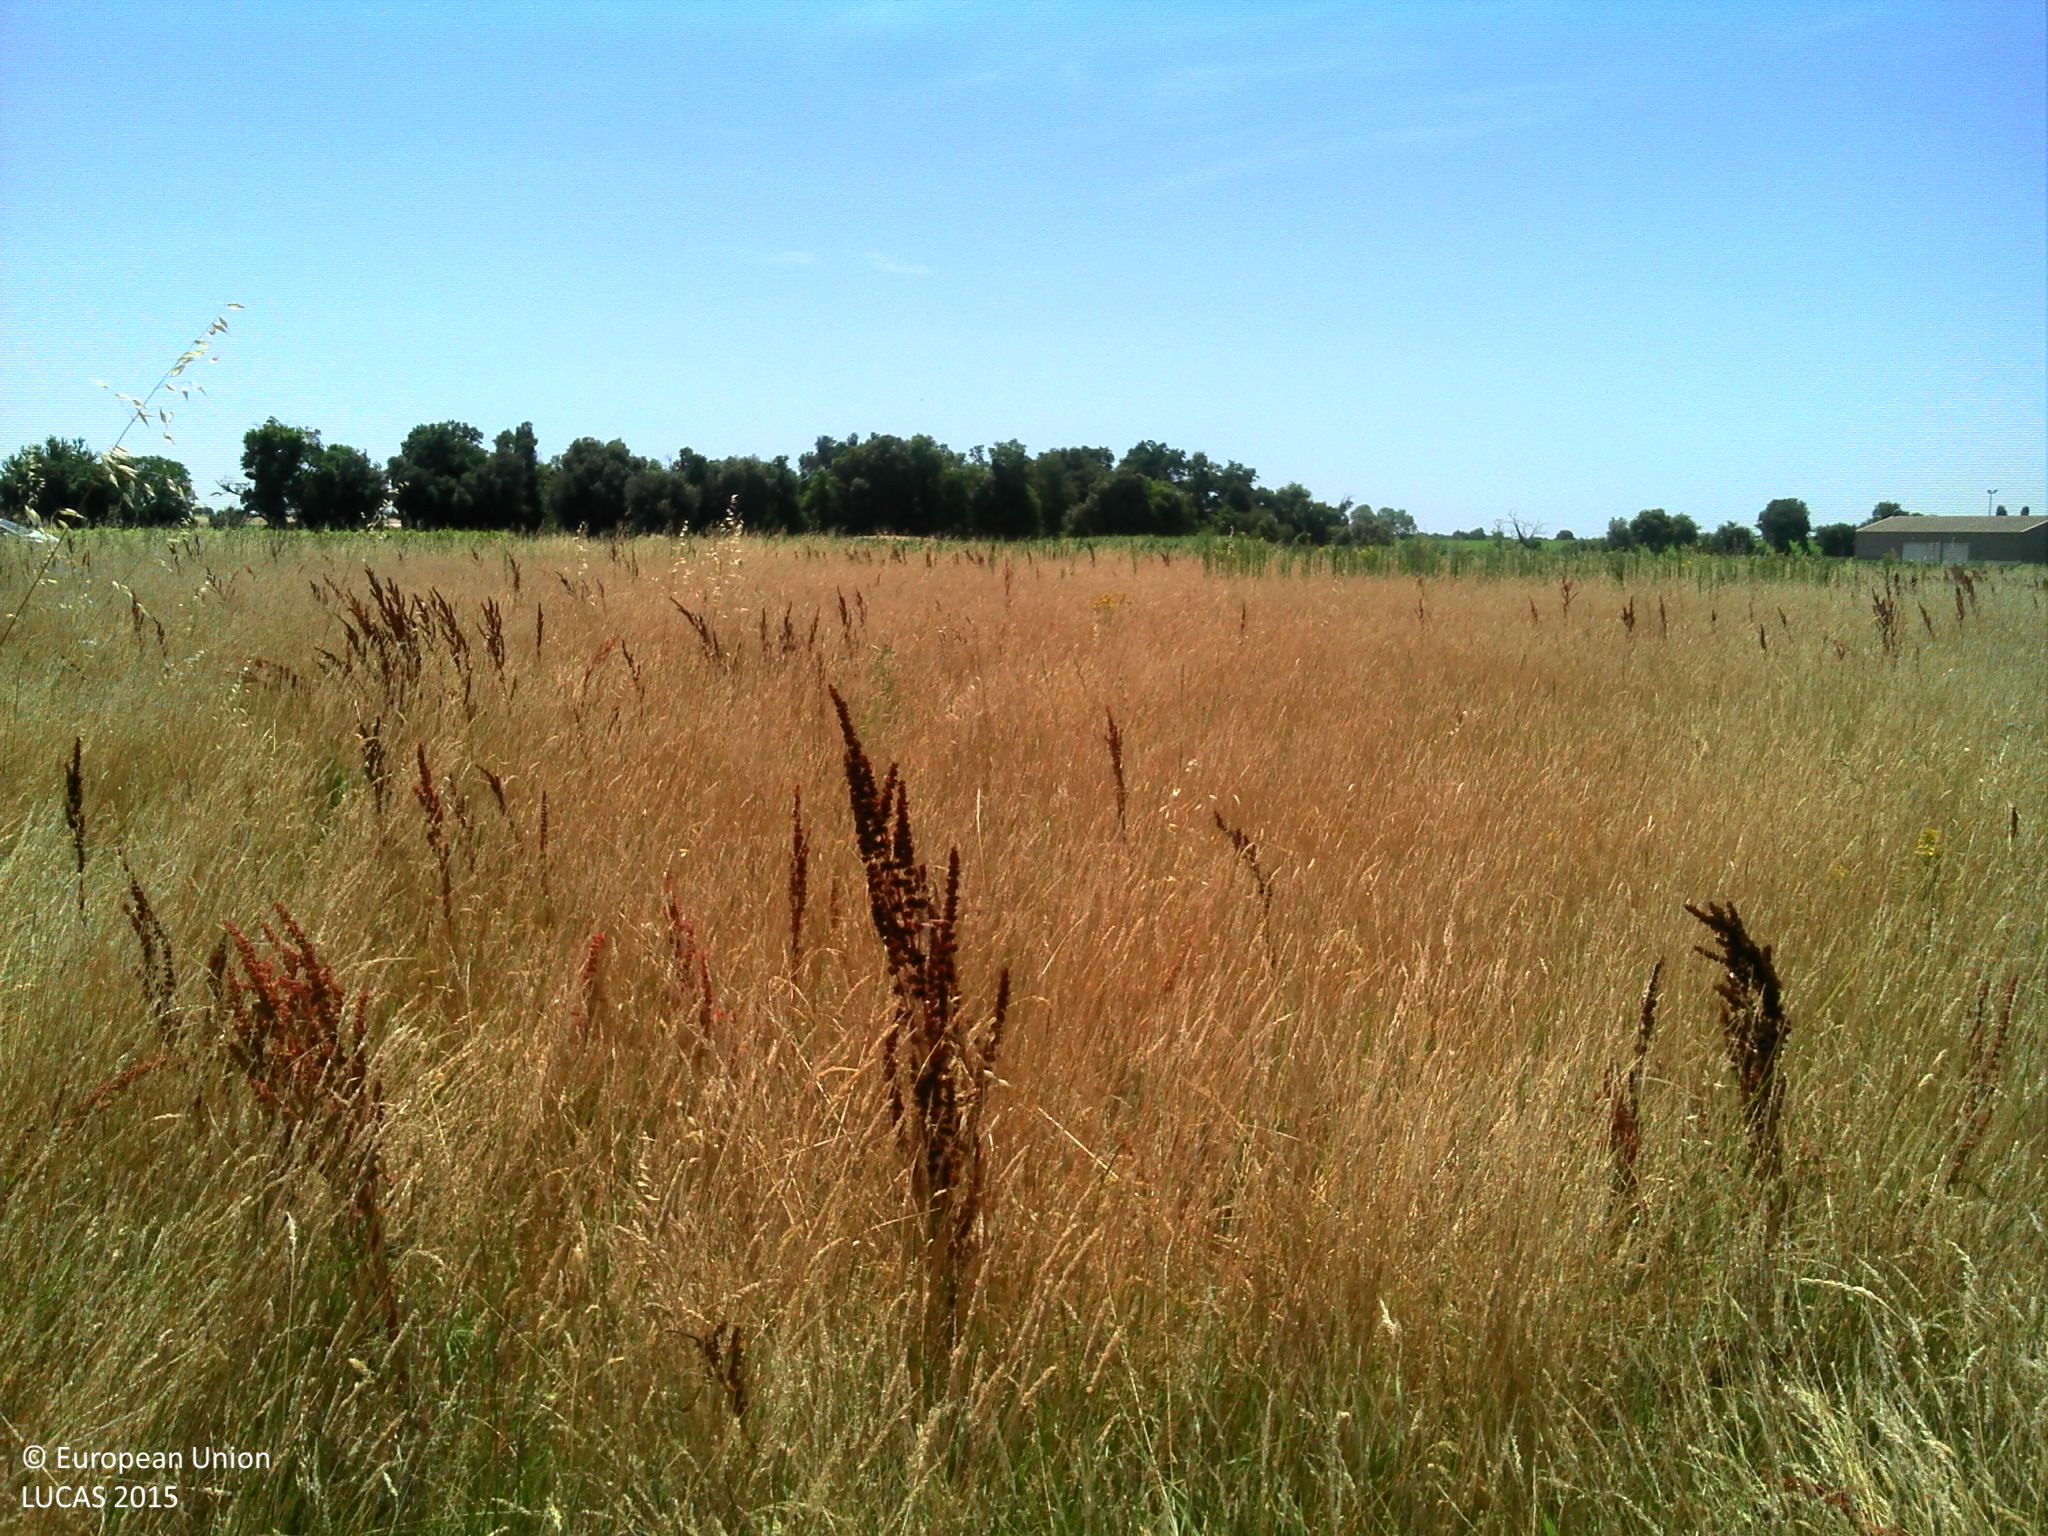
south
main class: Cropland
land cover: Rape and turnip rape
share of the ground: > 75 %
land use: Agriculture (excluding fallow land and kitchen gardens)
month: June
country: FR
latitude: 45.7215
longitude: -0.8833
